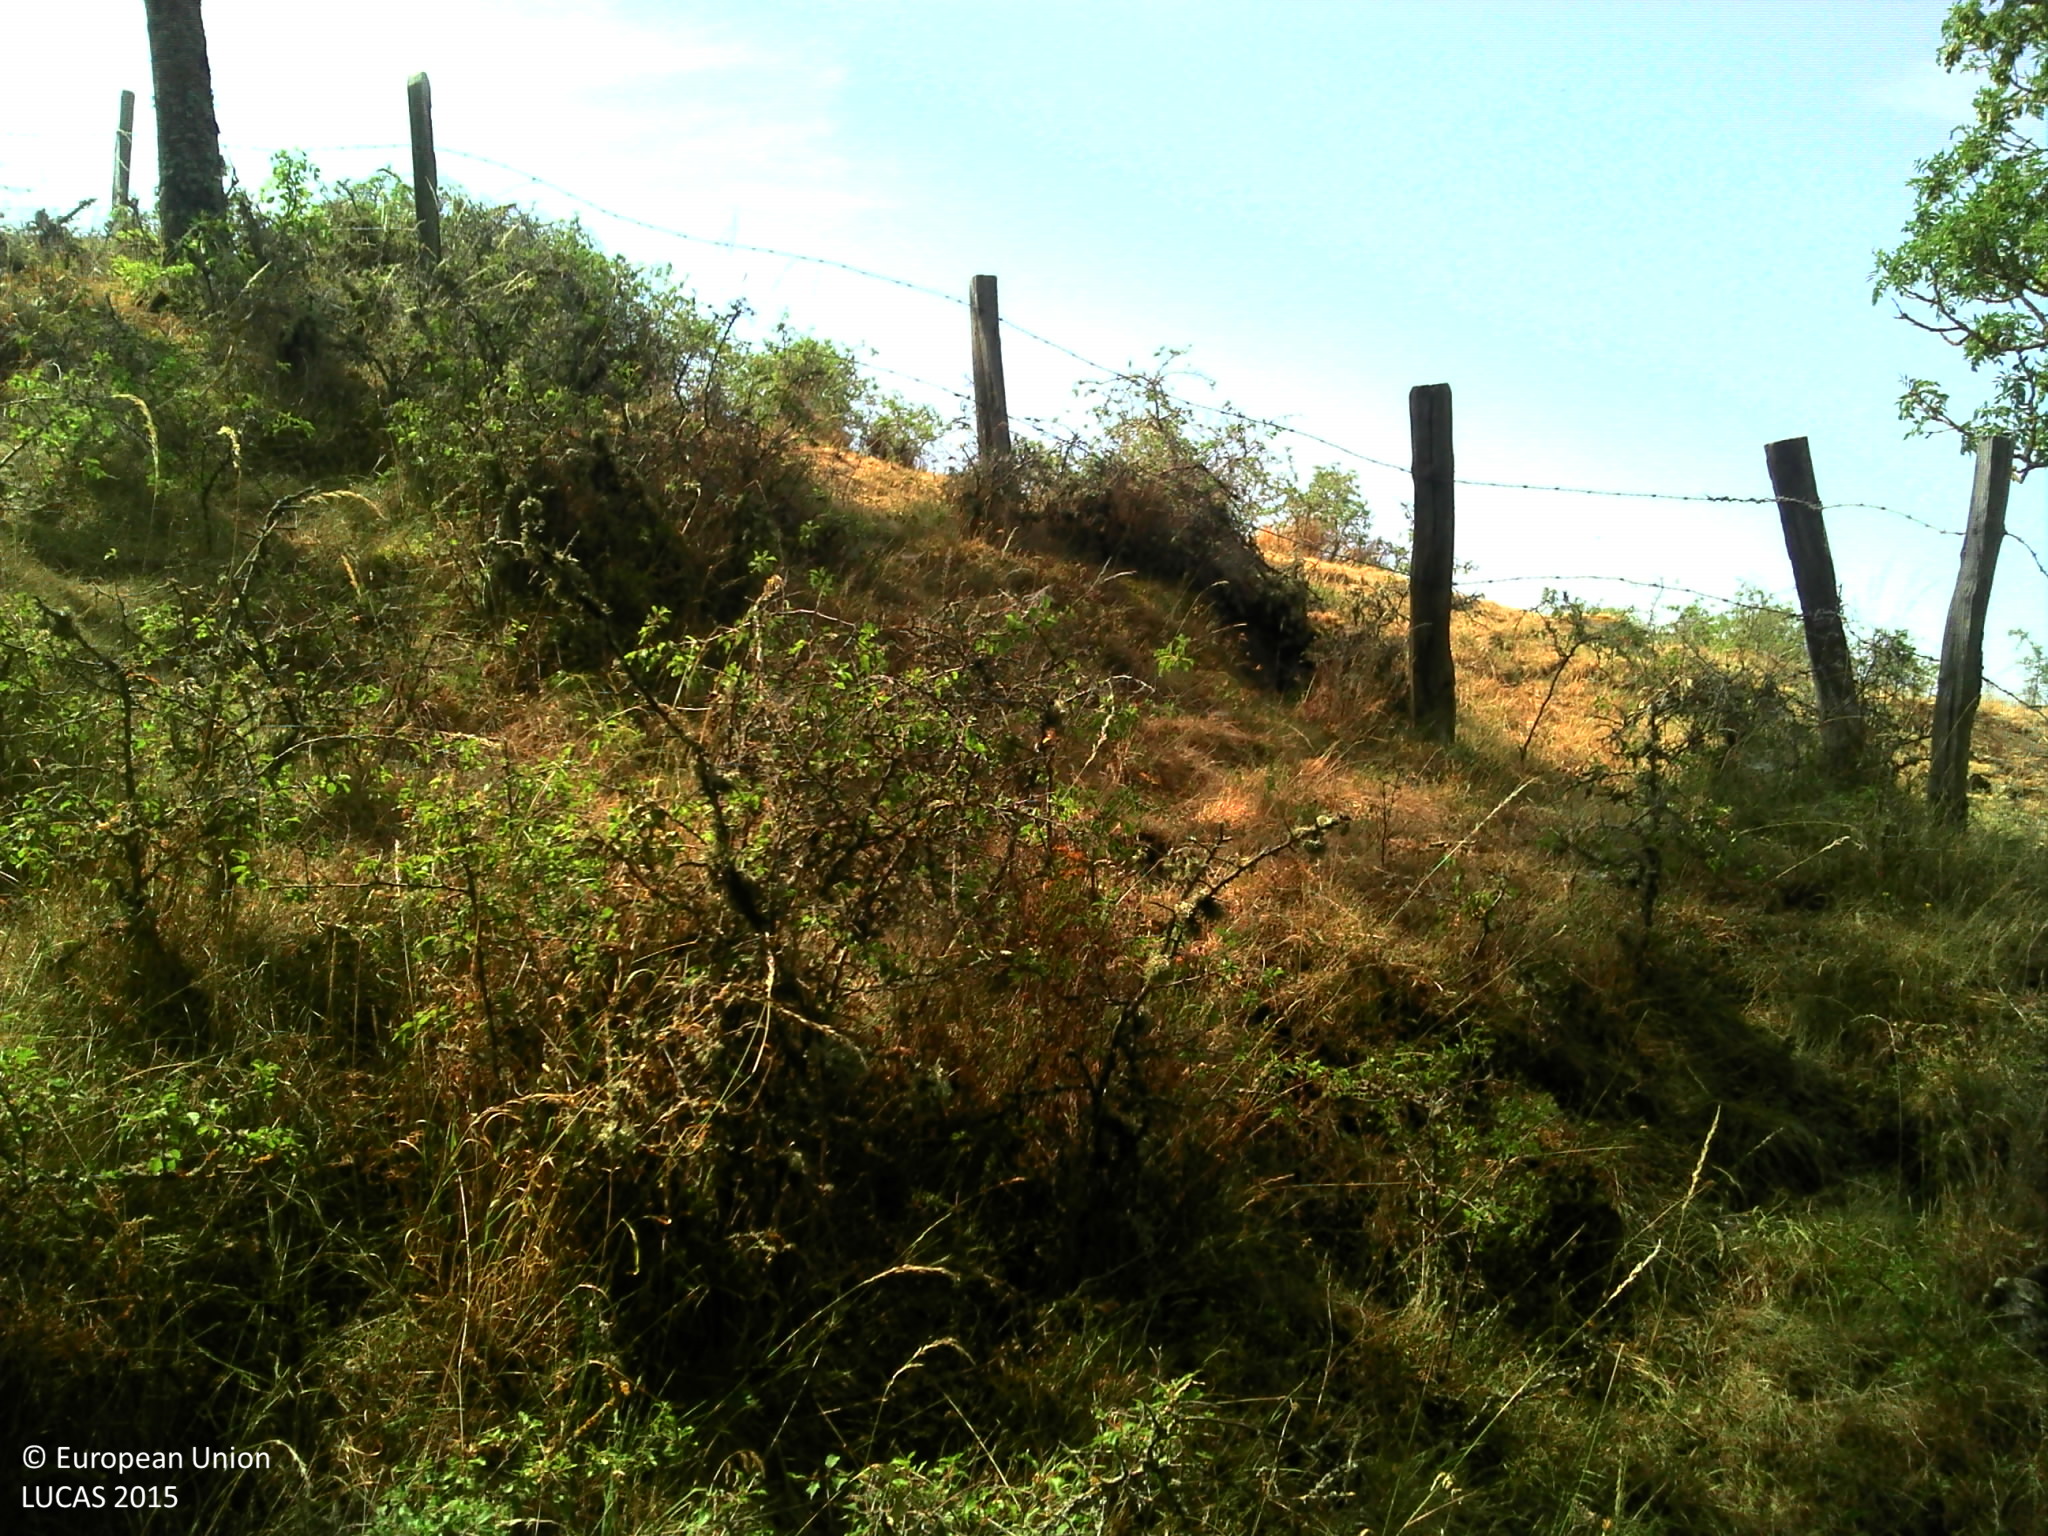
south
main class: Woodland
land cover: Broadleaved woodland
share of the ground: > 75 %
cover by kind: broadleaved forest trees 60 %, herbaceous plants 30 %, shrubs 10 %
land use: Agriculture (excluding fallow land and kitchen gardens)
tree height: > 5 m
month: July
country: FR
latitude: 45.1287
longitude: 3.0215
